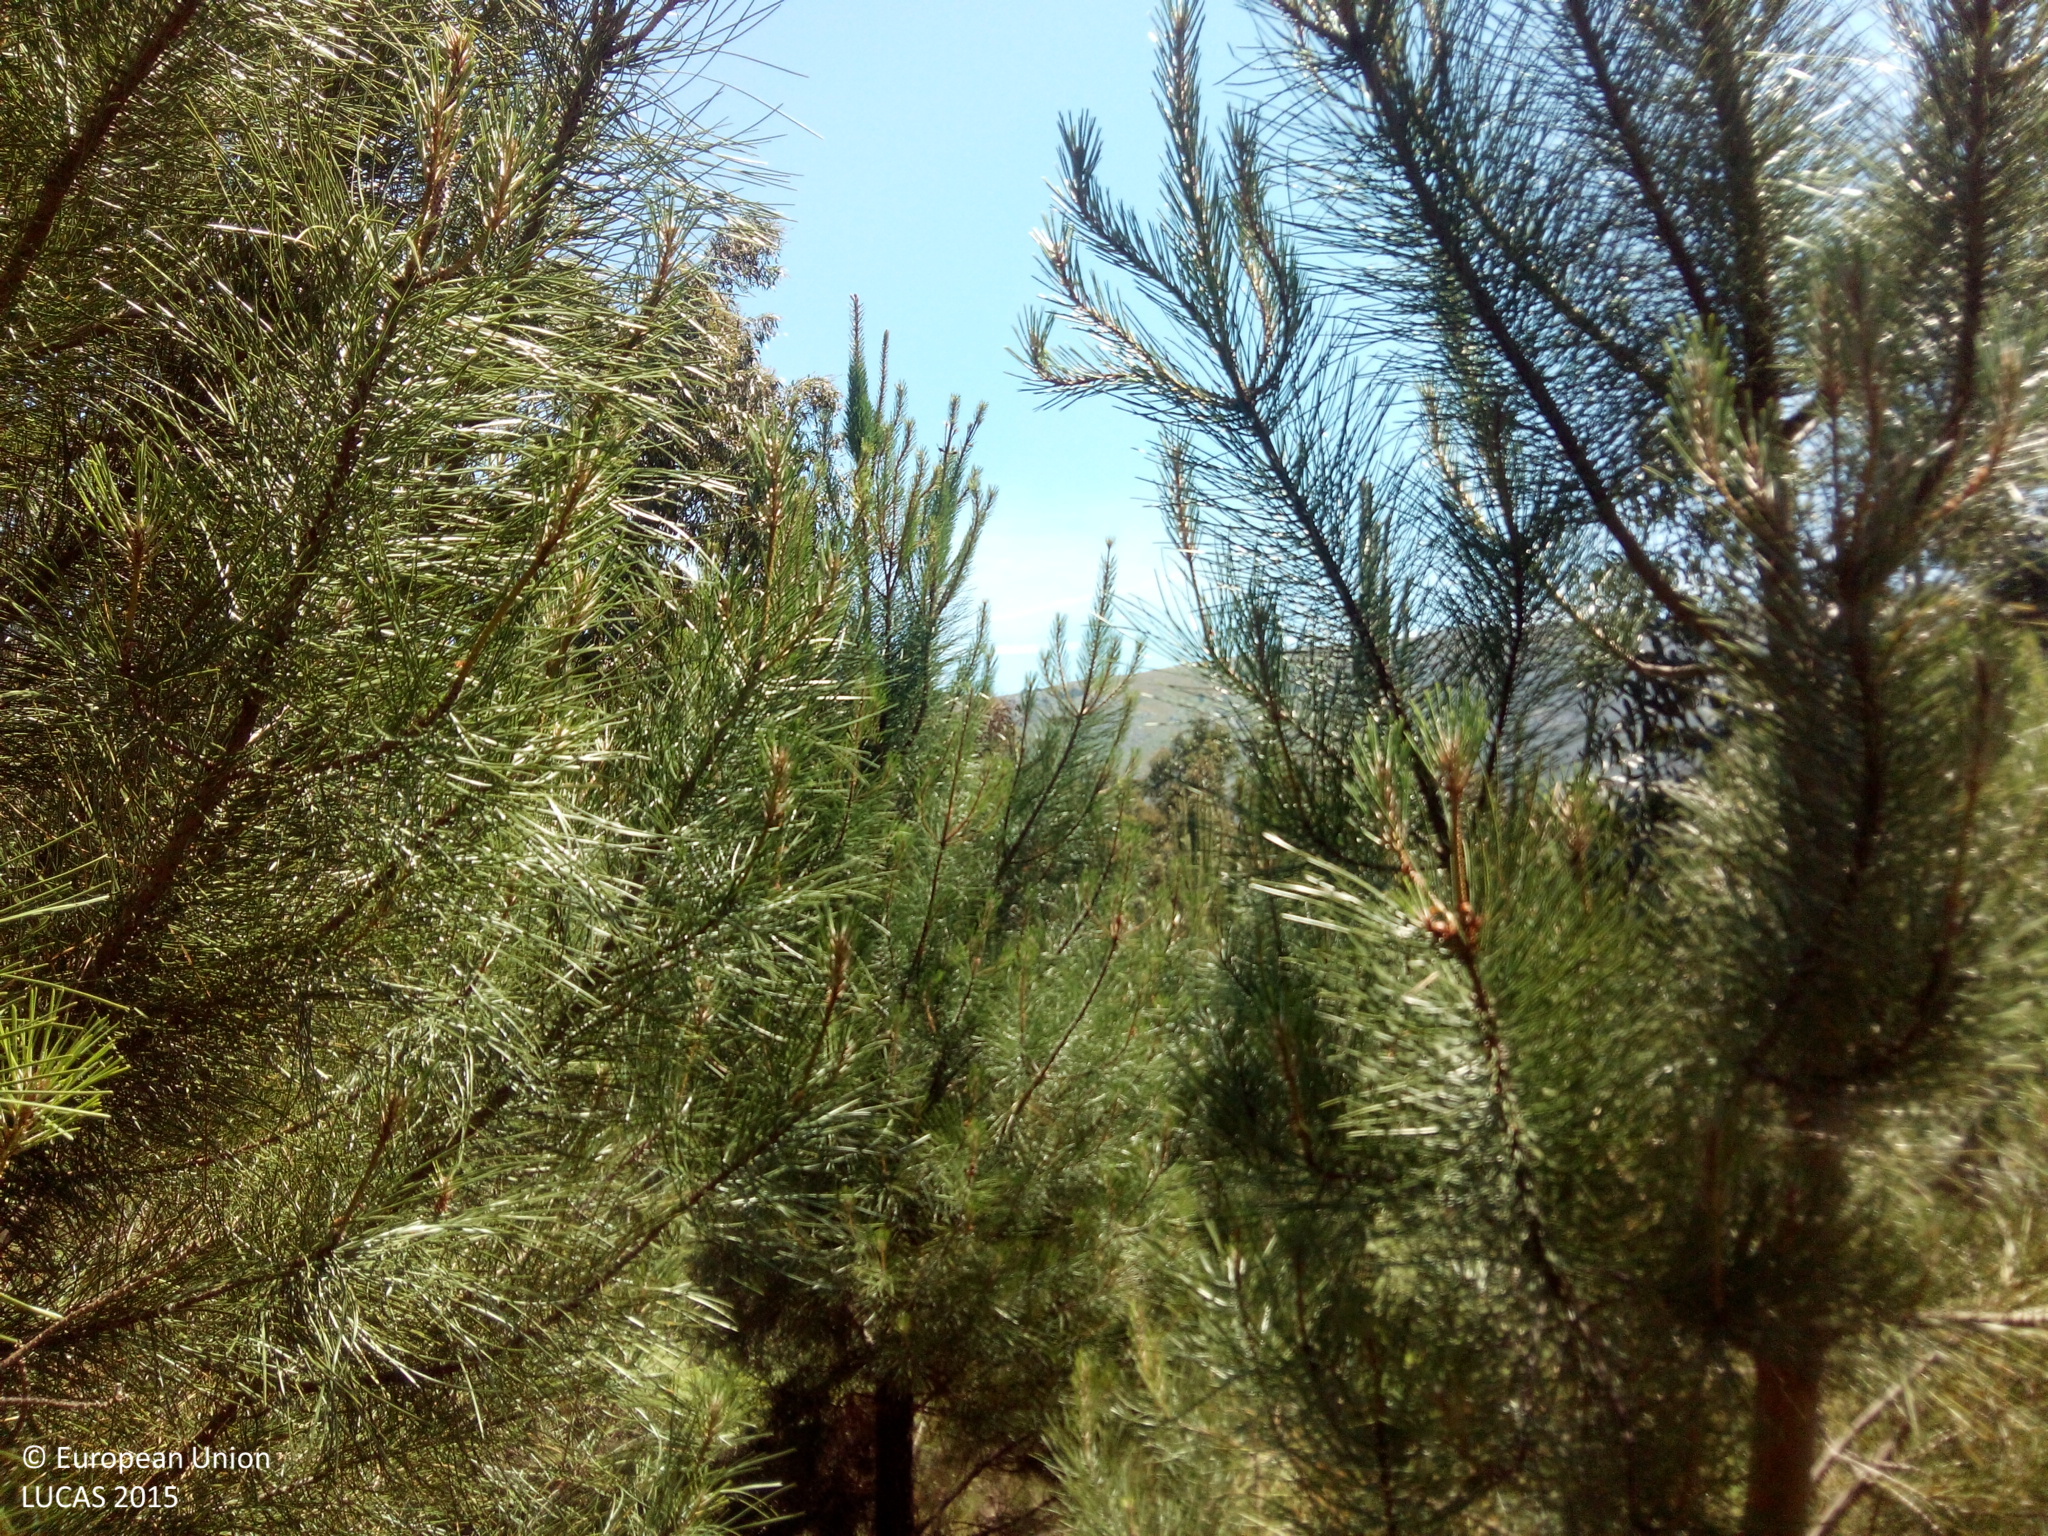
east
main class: Woodland
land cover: Pine dominated coniferous woodland
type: exotic forest
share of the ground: > 75 %
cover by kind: coniferous forest trees 70 %, shrubs 20 %, herbaceous plants 10 %
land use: Forestry
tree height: > 5 m
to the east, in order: Pine dominated coniferous woodland; Fences; Broadleaved woodland; Dry stone walls; Broadleaved woodland; Tracks; Broadleaved woodland; Dry stone walls; Pine dominated mixed woodland; Dry stone walls; Fences; Broadleaved woodland
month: May
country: ES
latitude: 42.6470
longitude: -9.0099
